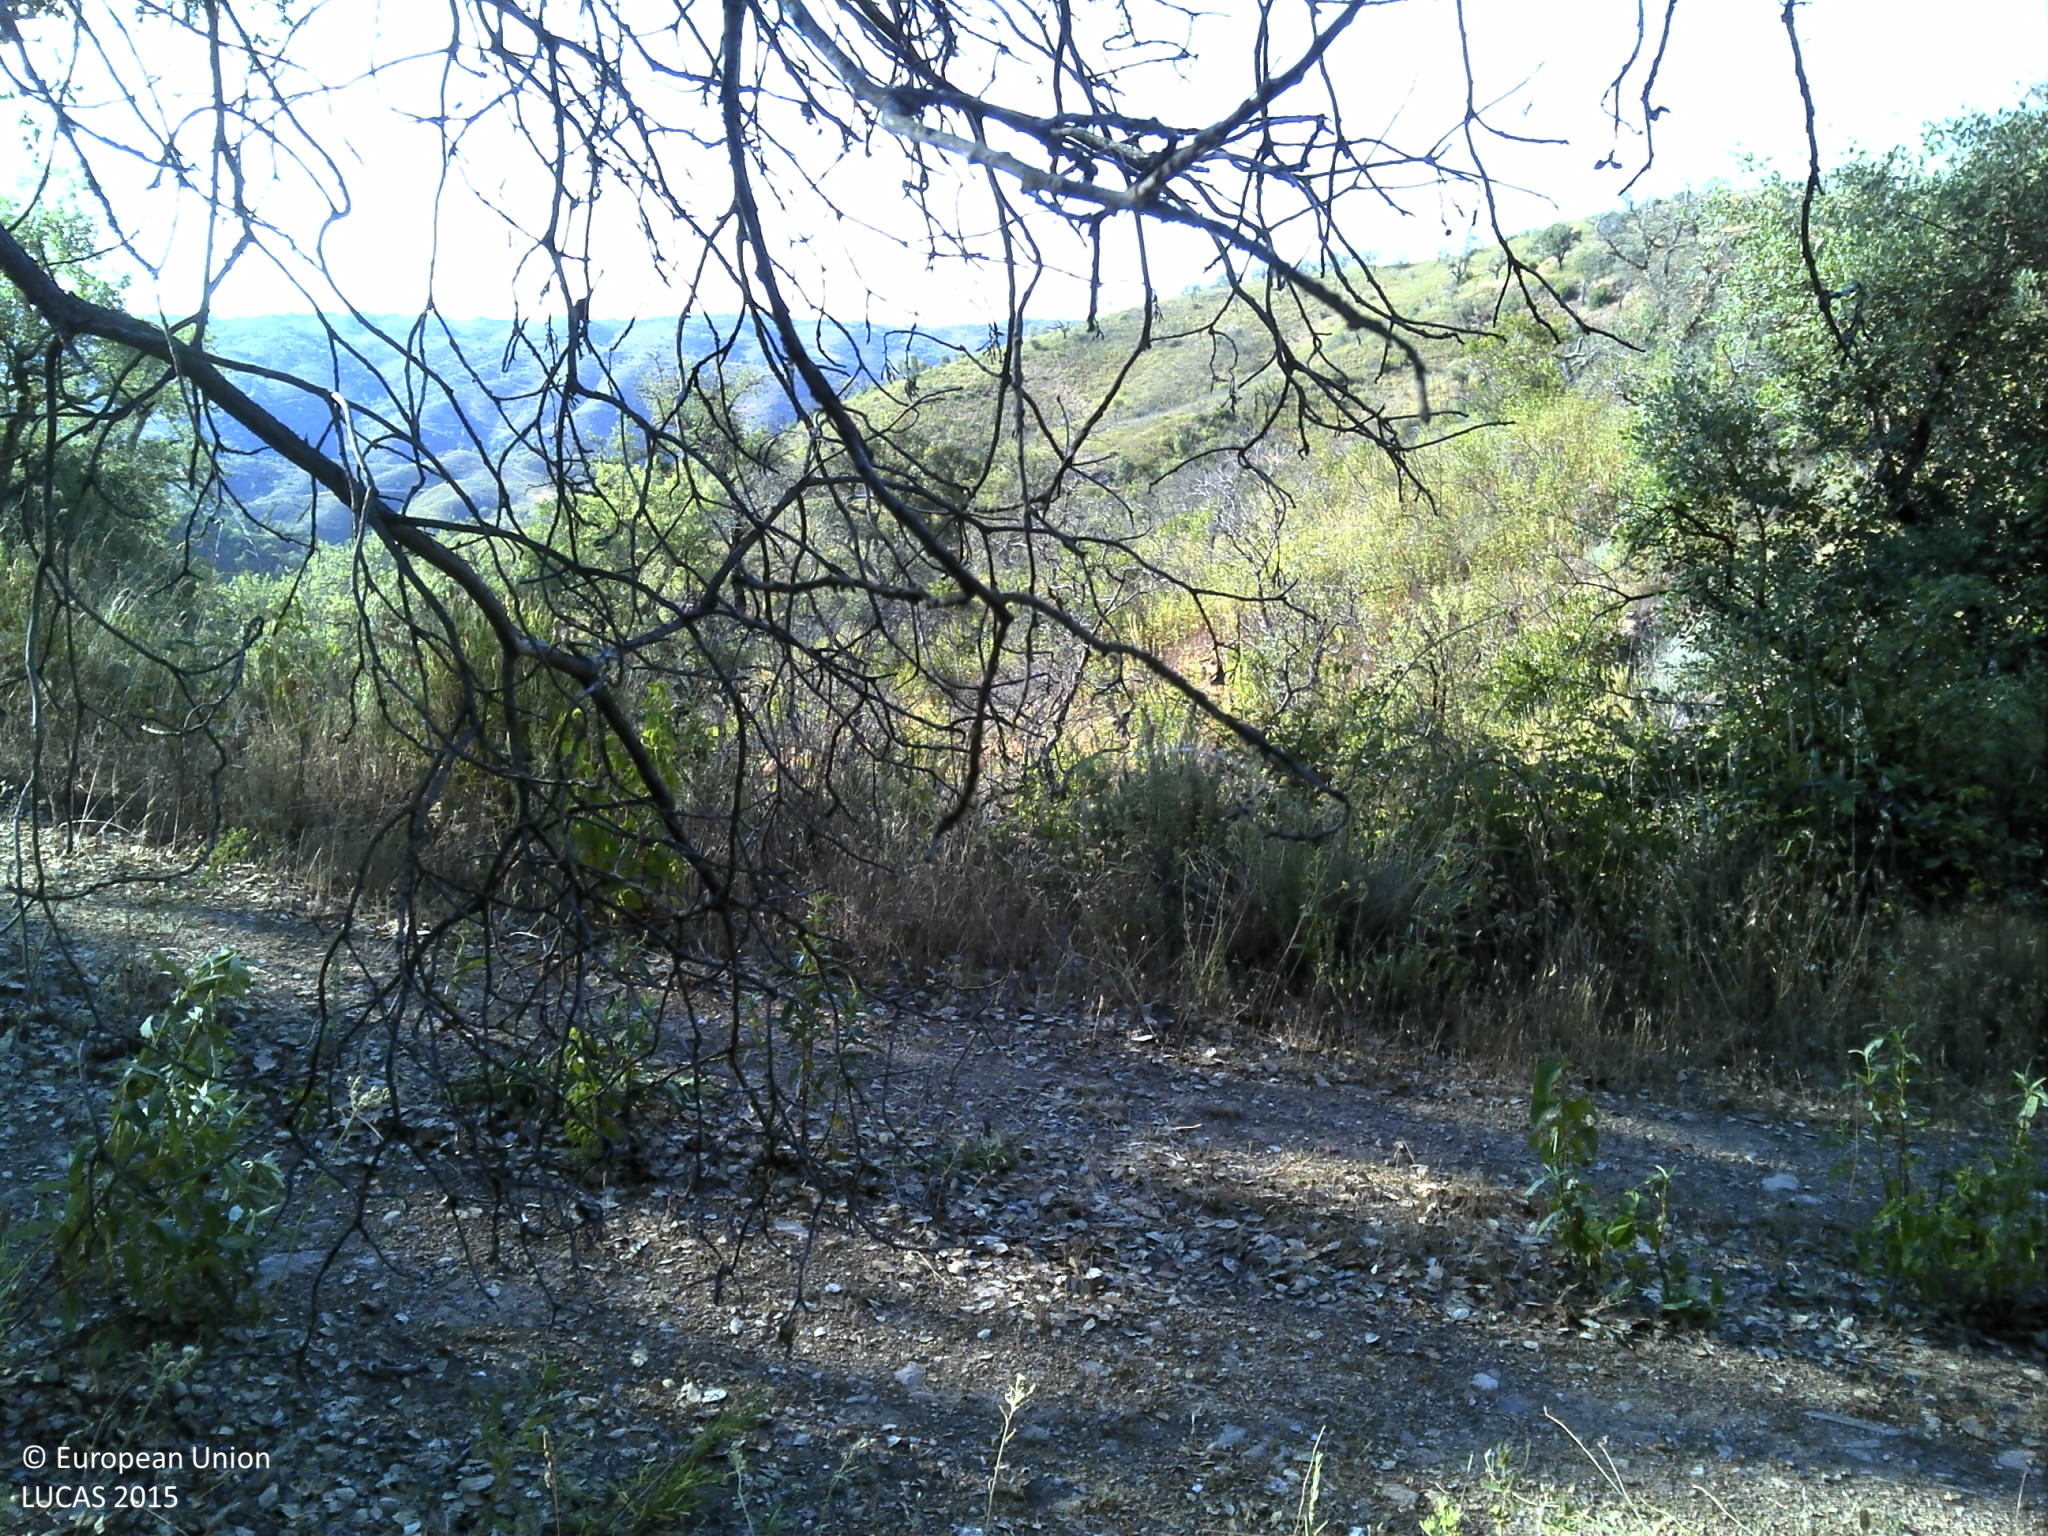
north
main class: Woodland
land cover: Broadleaved woodland
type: broadleaved evergreen forest
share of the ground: 25 - 50 %
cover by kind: broadleaved forest trees 45 %, shrubs 30 %, unconsolidated bare surface 20 %, herbaceous plants 5 %
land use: Forestry
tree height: > 5 m
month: June
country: PT
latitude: 37.2456
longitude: -7.8576
